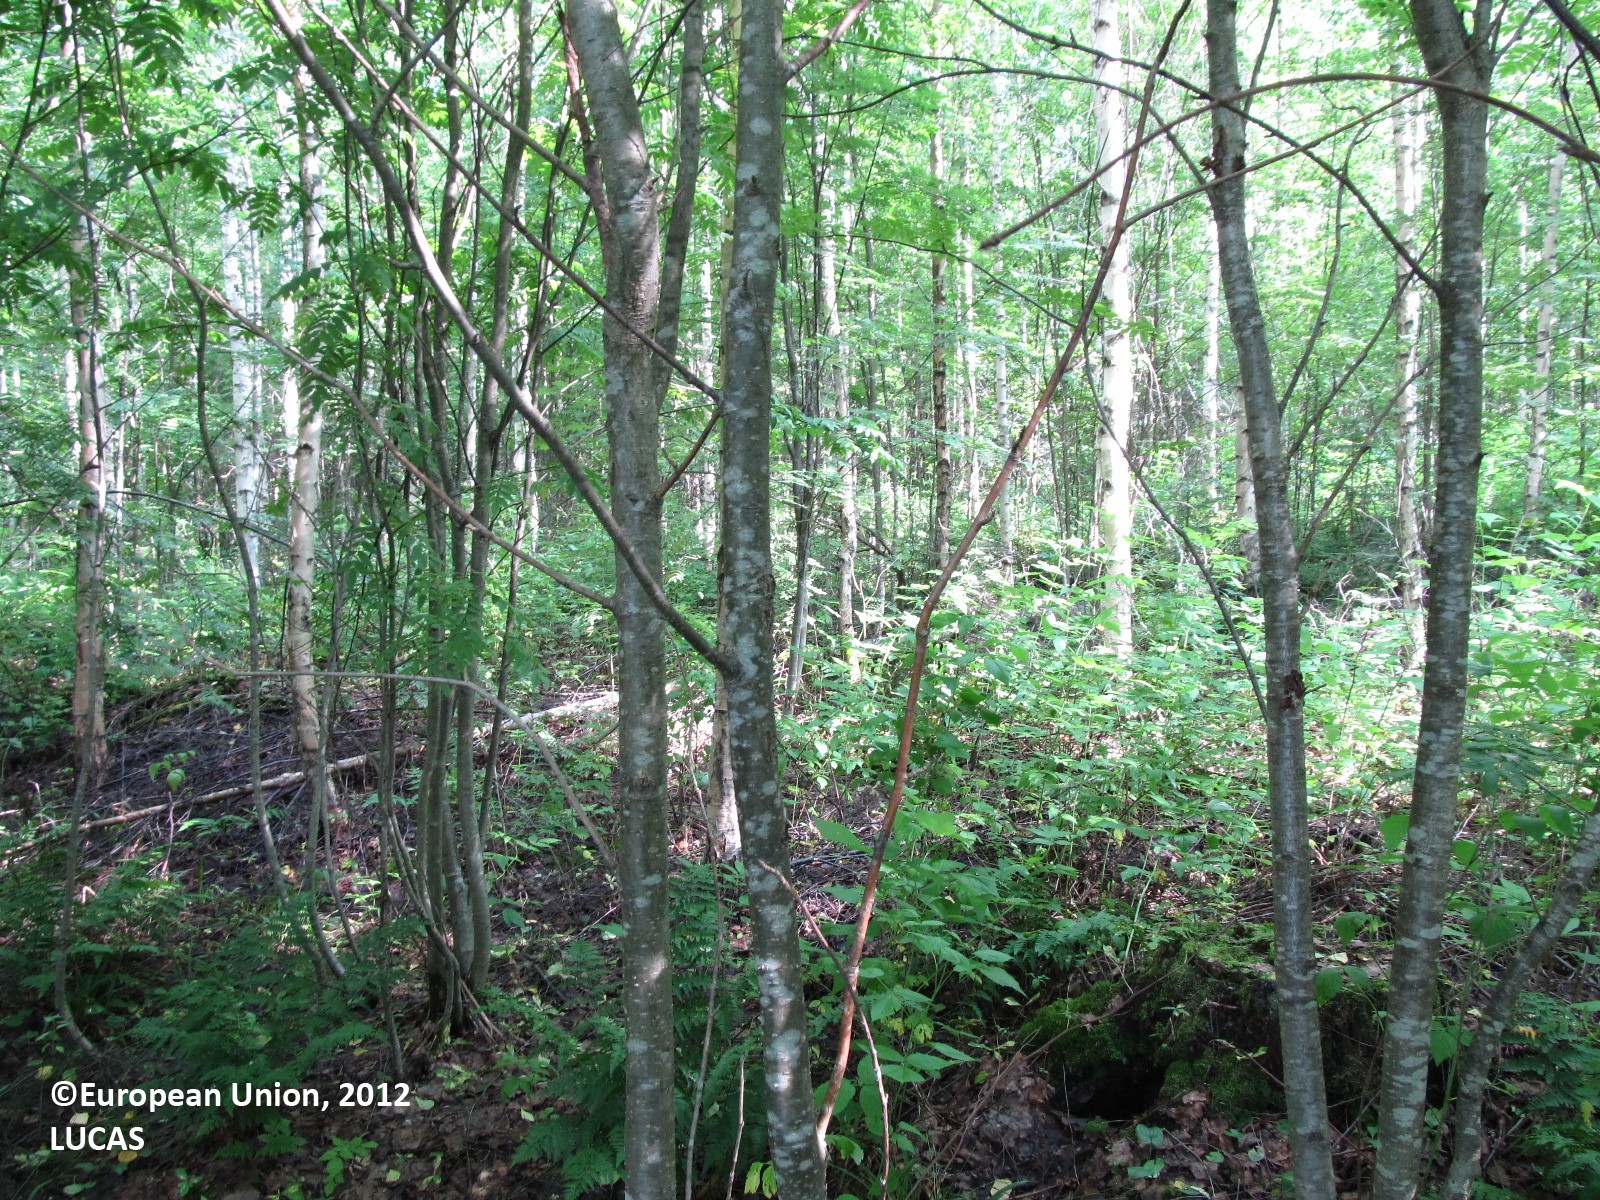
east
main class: Woodland
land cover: Broadleaved woodland
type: boreal forest
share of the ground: 25 - 50 %
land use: Forestry
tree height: > 5 m
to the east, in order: Broadleaved woodland; Spruce dominated mixed woodland; Broadleaved woodland; Ditches and canals; Grass margins; Paved roads, cycling and walking lanes; Grass margins; Broadleaved woodland; Electric lines; Ditches and canals; Grass margins; Paved roads, cycling and walking lanes
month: July
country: FI
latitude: 62.0558
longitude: 28.1162
